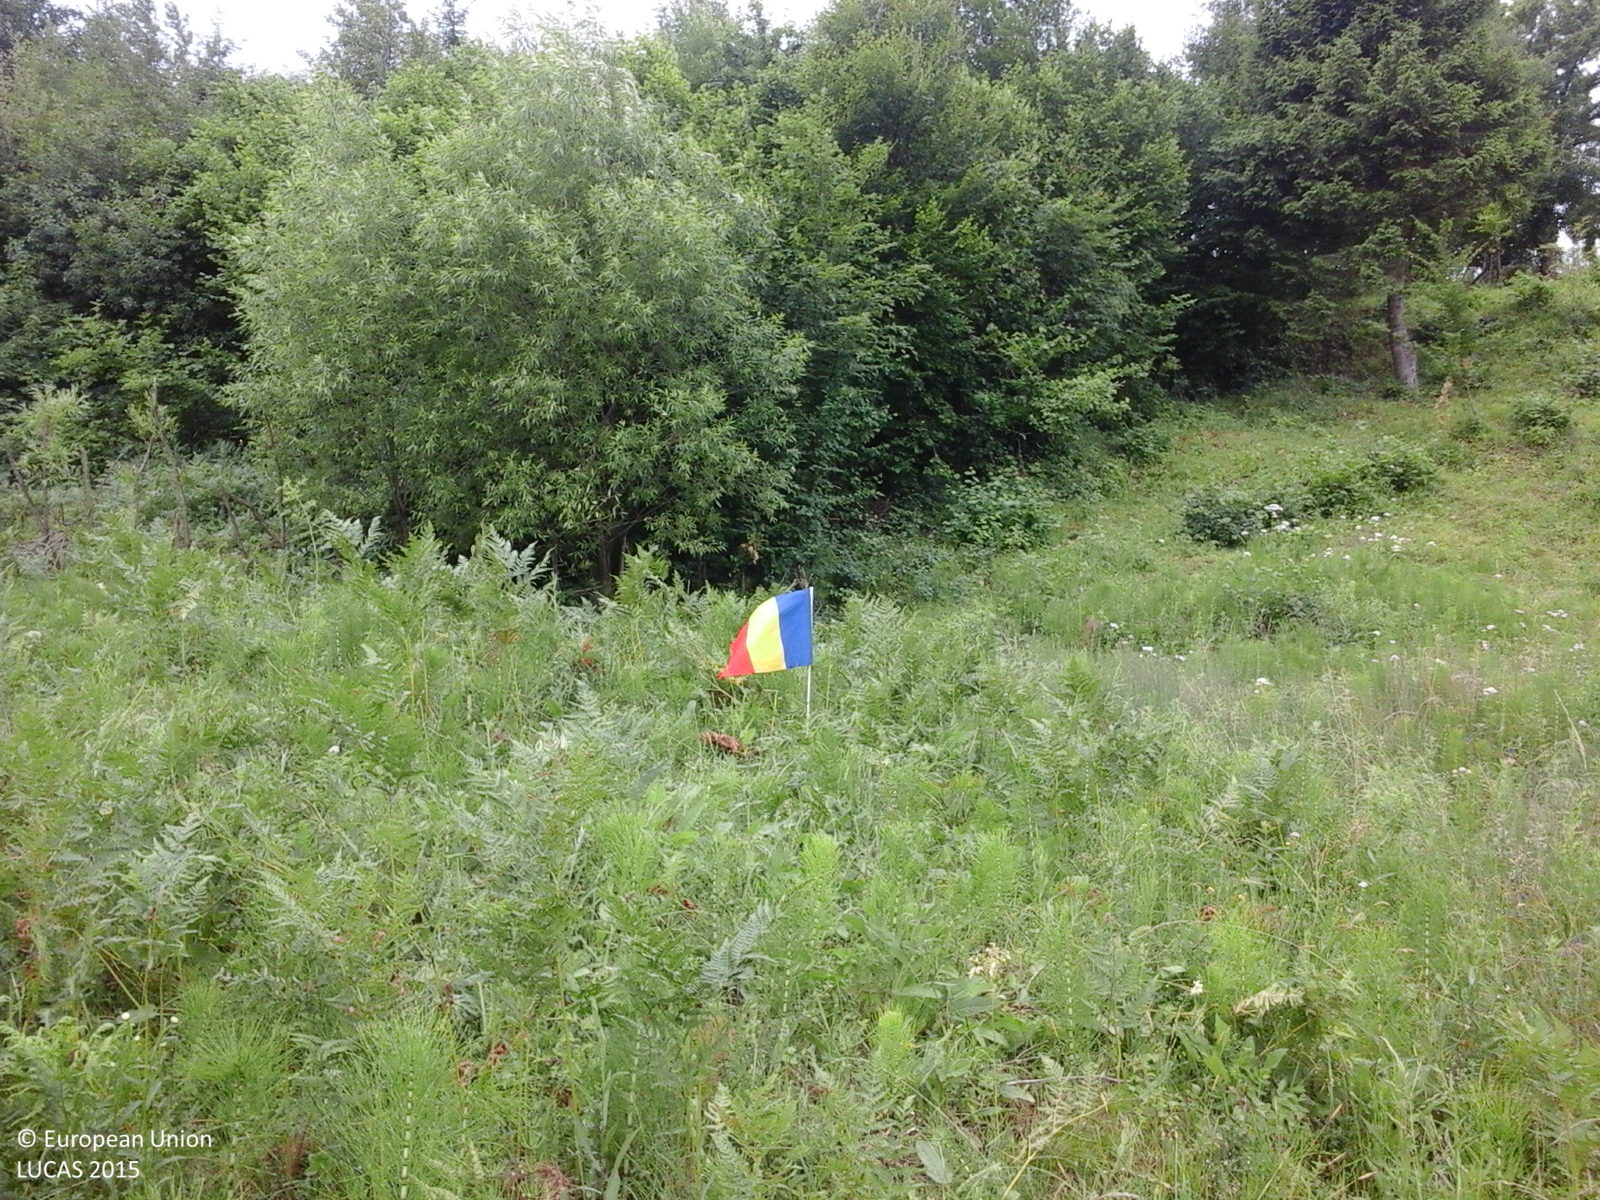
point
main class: Grassland
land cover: Spontaneously vegetated surfaces
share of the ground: > 75 %
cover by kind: herbaceous plants 100 %
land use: Agriculture (excluding fallow land and kitchen gardens)
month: June
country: RO
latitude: 47.3389
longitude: 26.2406
